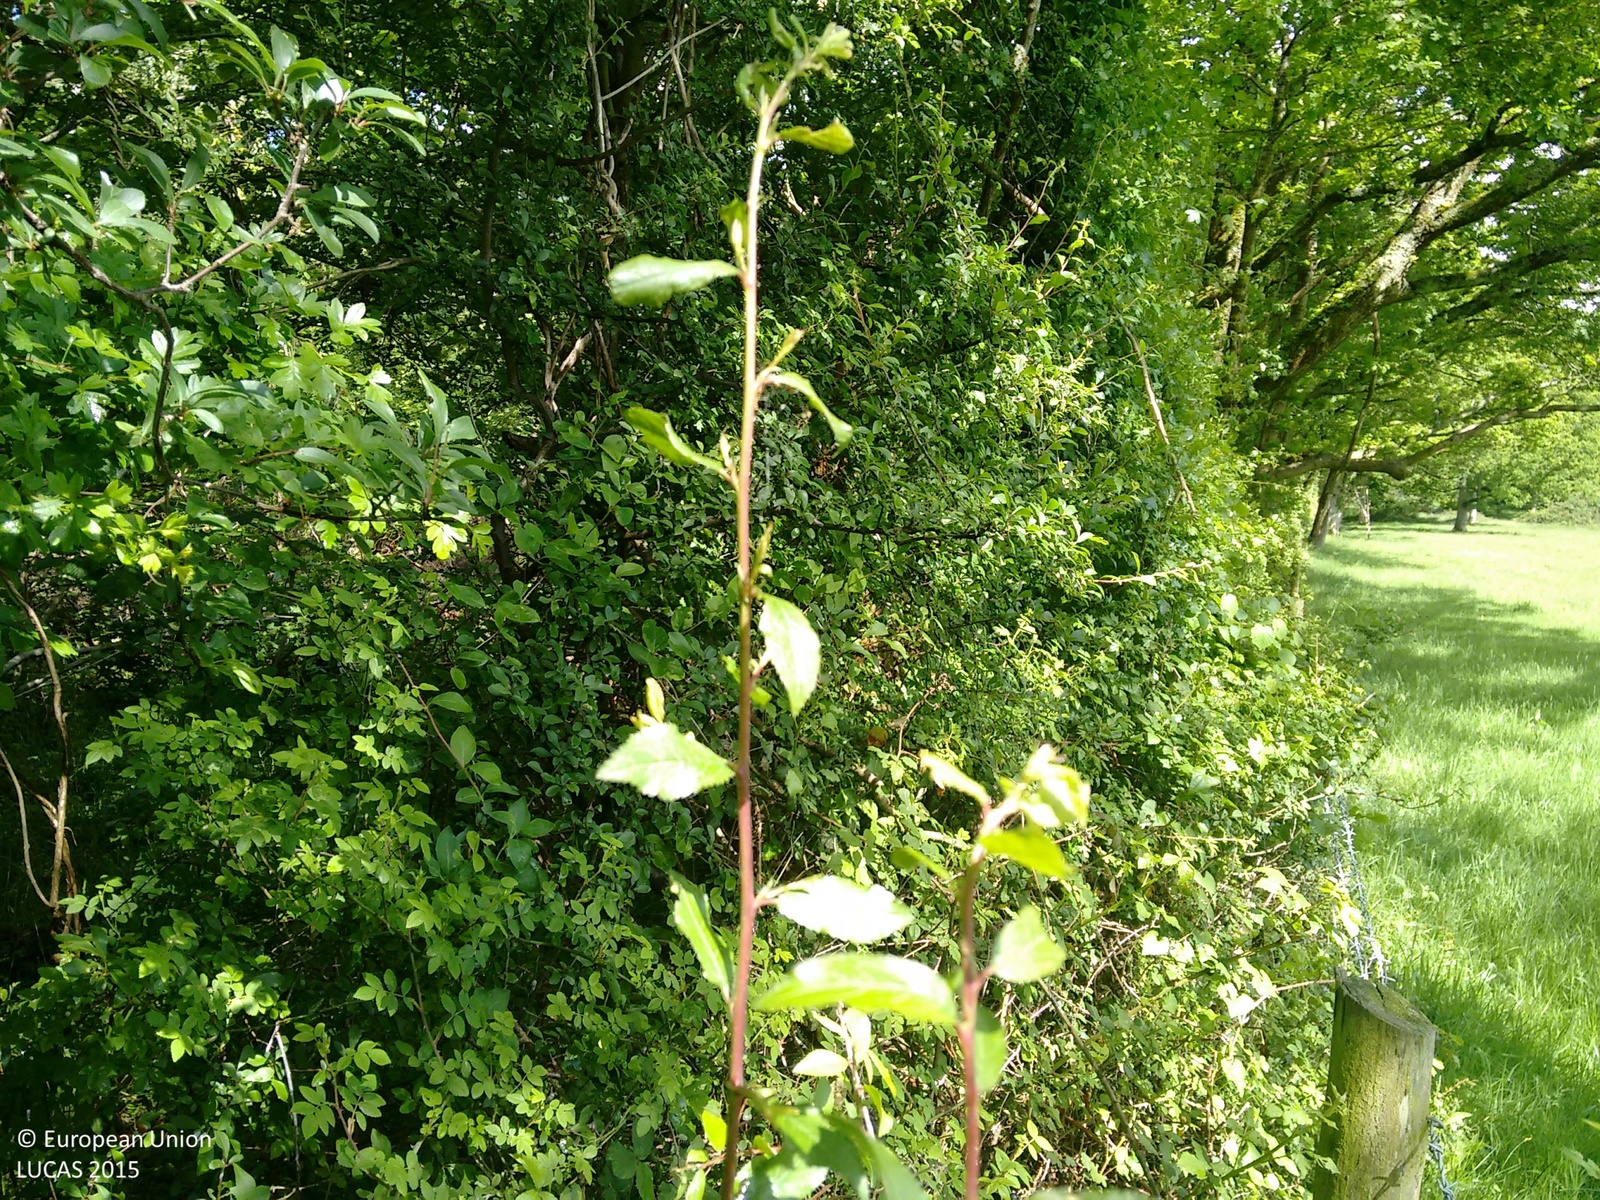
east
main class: Woodland
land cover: Broadleaved woodland
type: mesophytic deciduous forest
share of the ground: > 75 %
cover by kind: broadleaved forest trees 100 %
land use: Forestry
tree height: > 5 m
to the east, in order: Broadleaved woodland
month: May
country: GB
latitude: 51.0108
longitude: -1.3806
